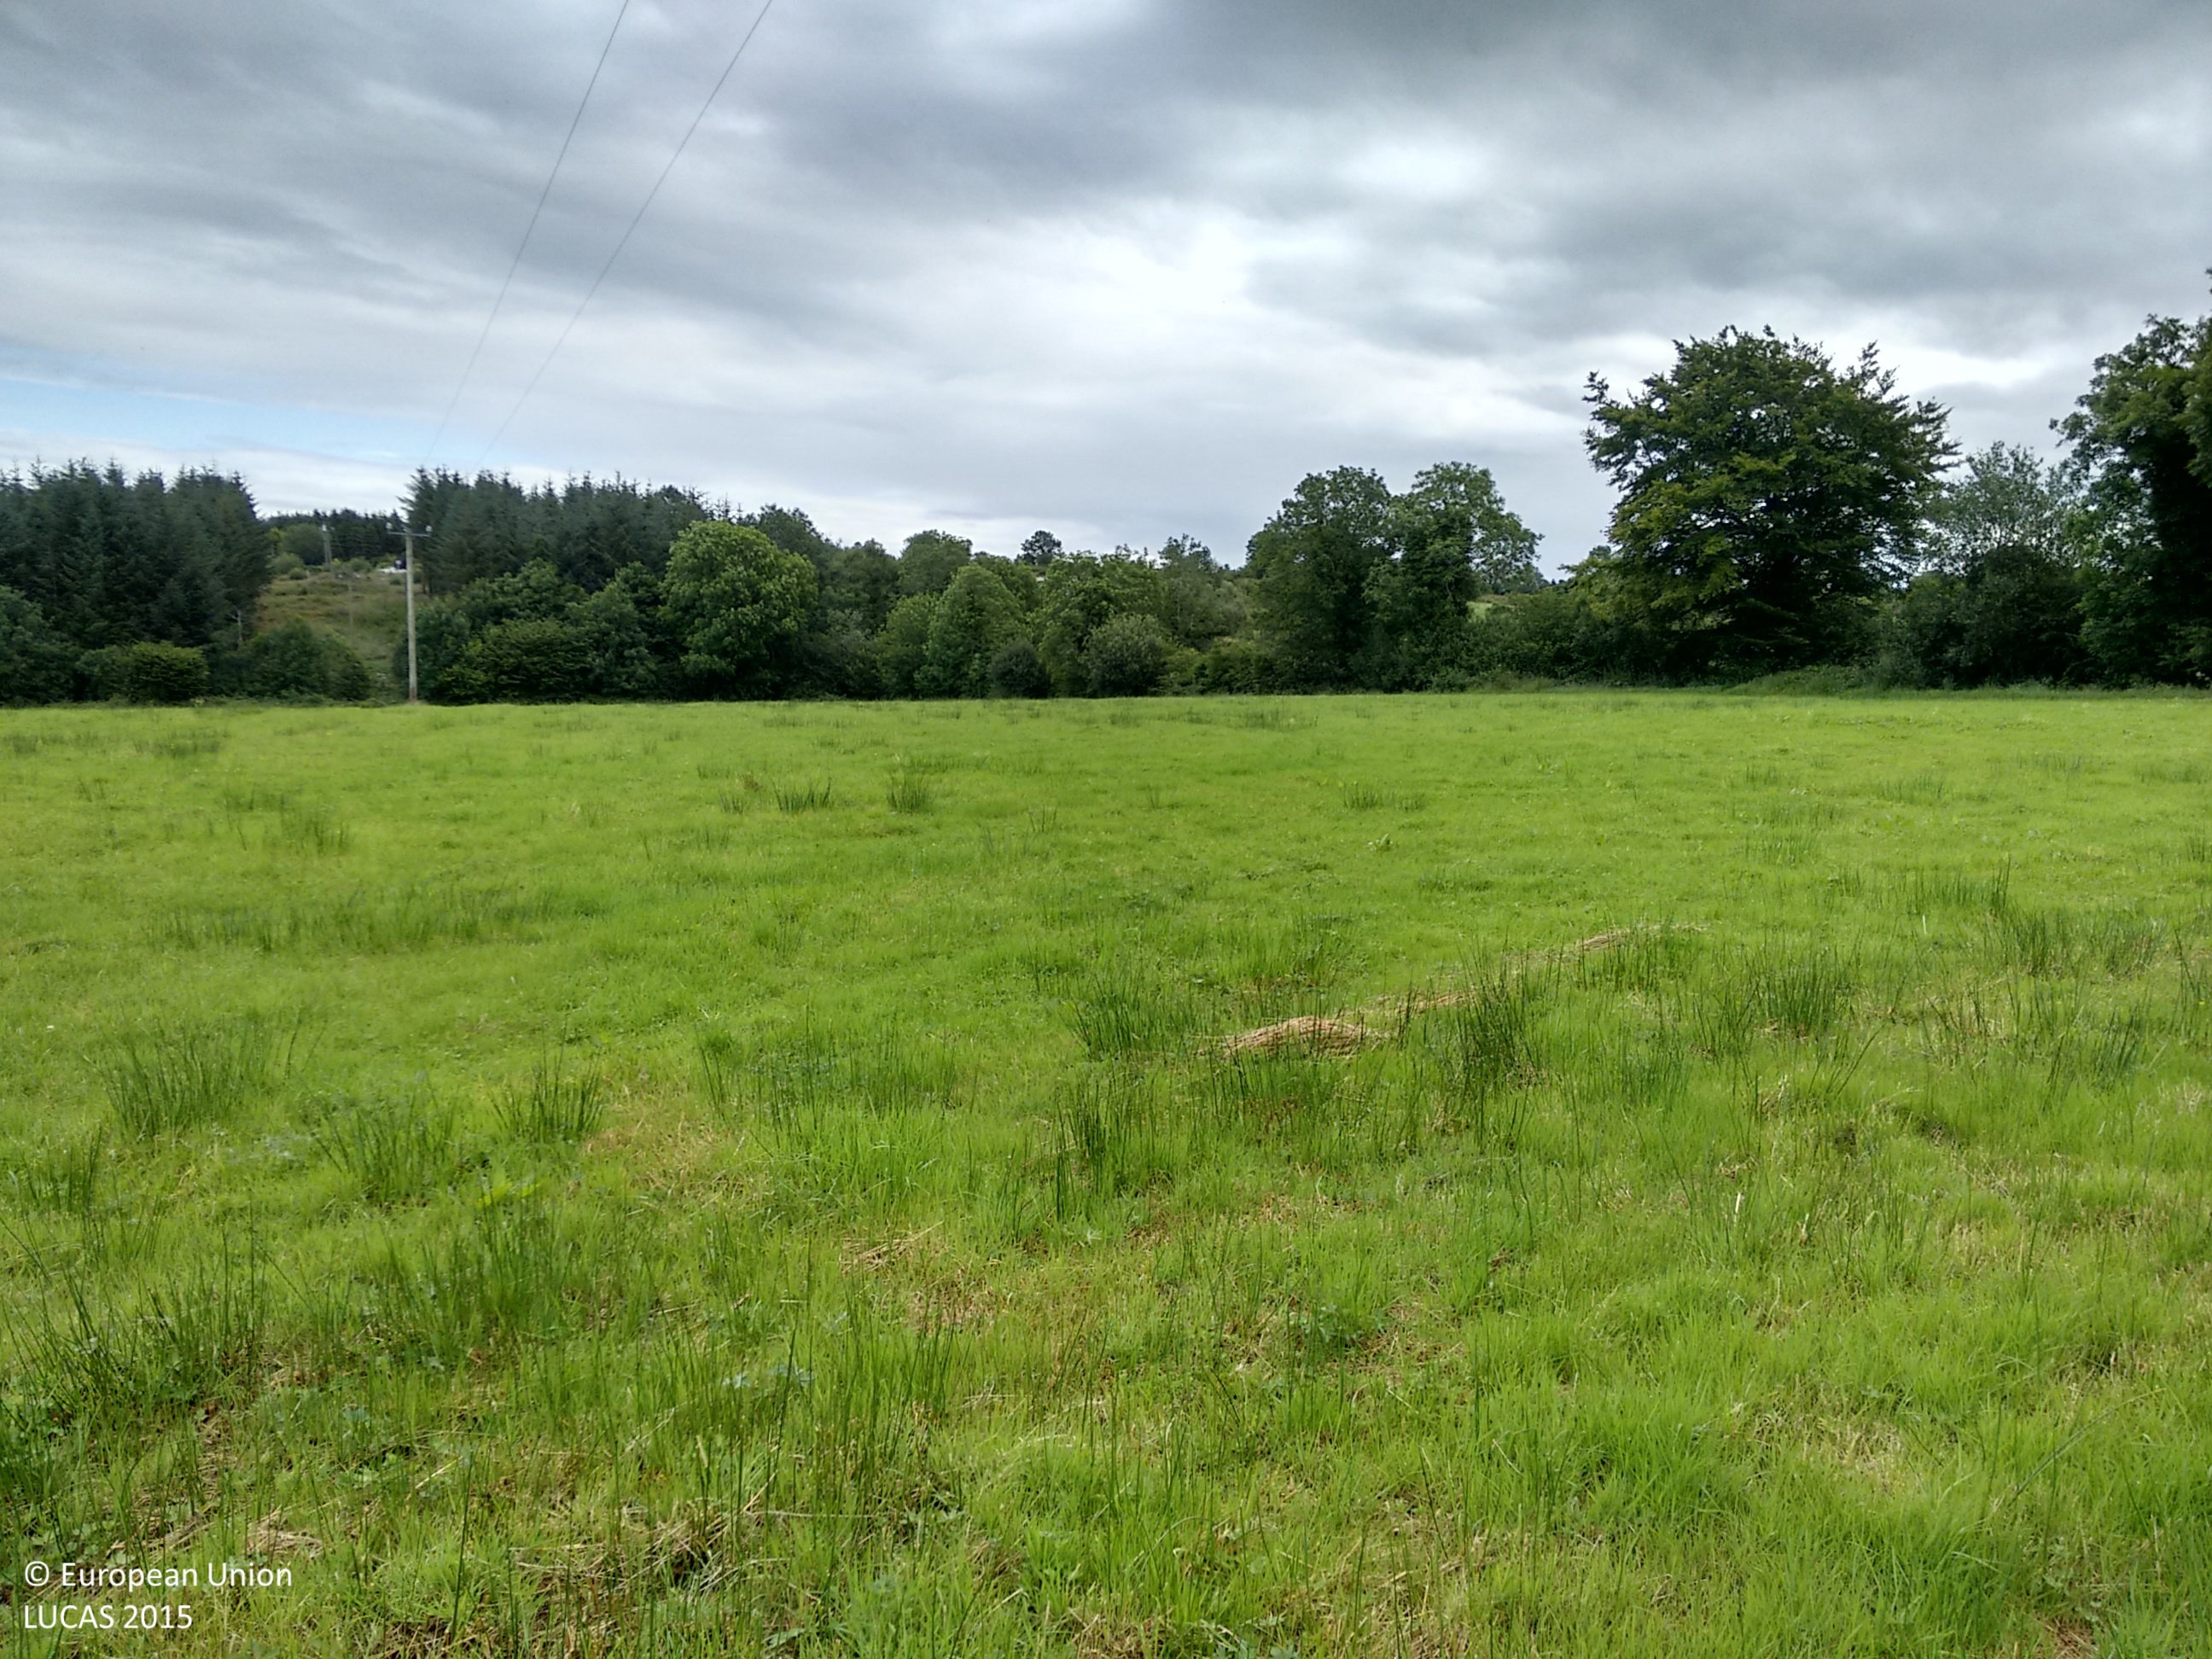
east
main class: Grassland
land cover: Grassland without tree/shrub cover
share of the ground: > 75 %
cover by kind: herbaceous plants 95 %, shrubs 5 %
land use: Agriculture (excluding fallow land and kitchen gardens)
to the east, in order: Grassland without tree/shrub cover; Electric lines; Grassland without tree/shrub cover; Grass margins; Ditches and canals; Abandoned hedges; Artificial constructions in urban areas; Shrubland with sparse tree cover; Electric lines; Managed hedges; Grass margins; Paved roads, cycling and walking lanes; Grass margins; Dry stone walls; Artificial constructions; Abandoned hedges; Shrubland with sparse tree cover; Electric lines; Grassland without tree/shrub cover
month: July
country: IE
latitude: 53.8452
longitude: -7.7514
